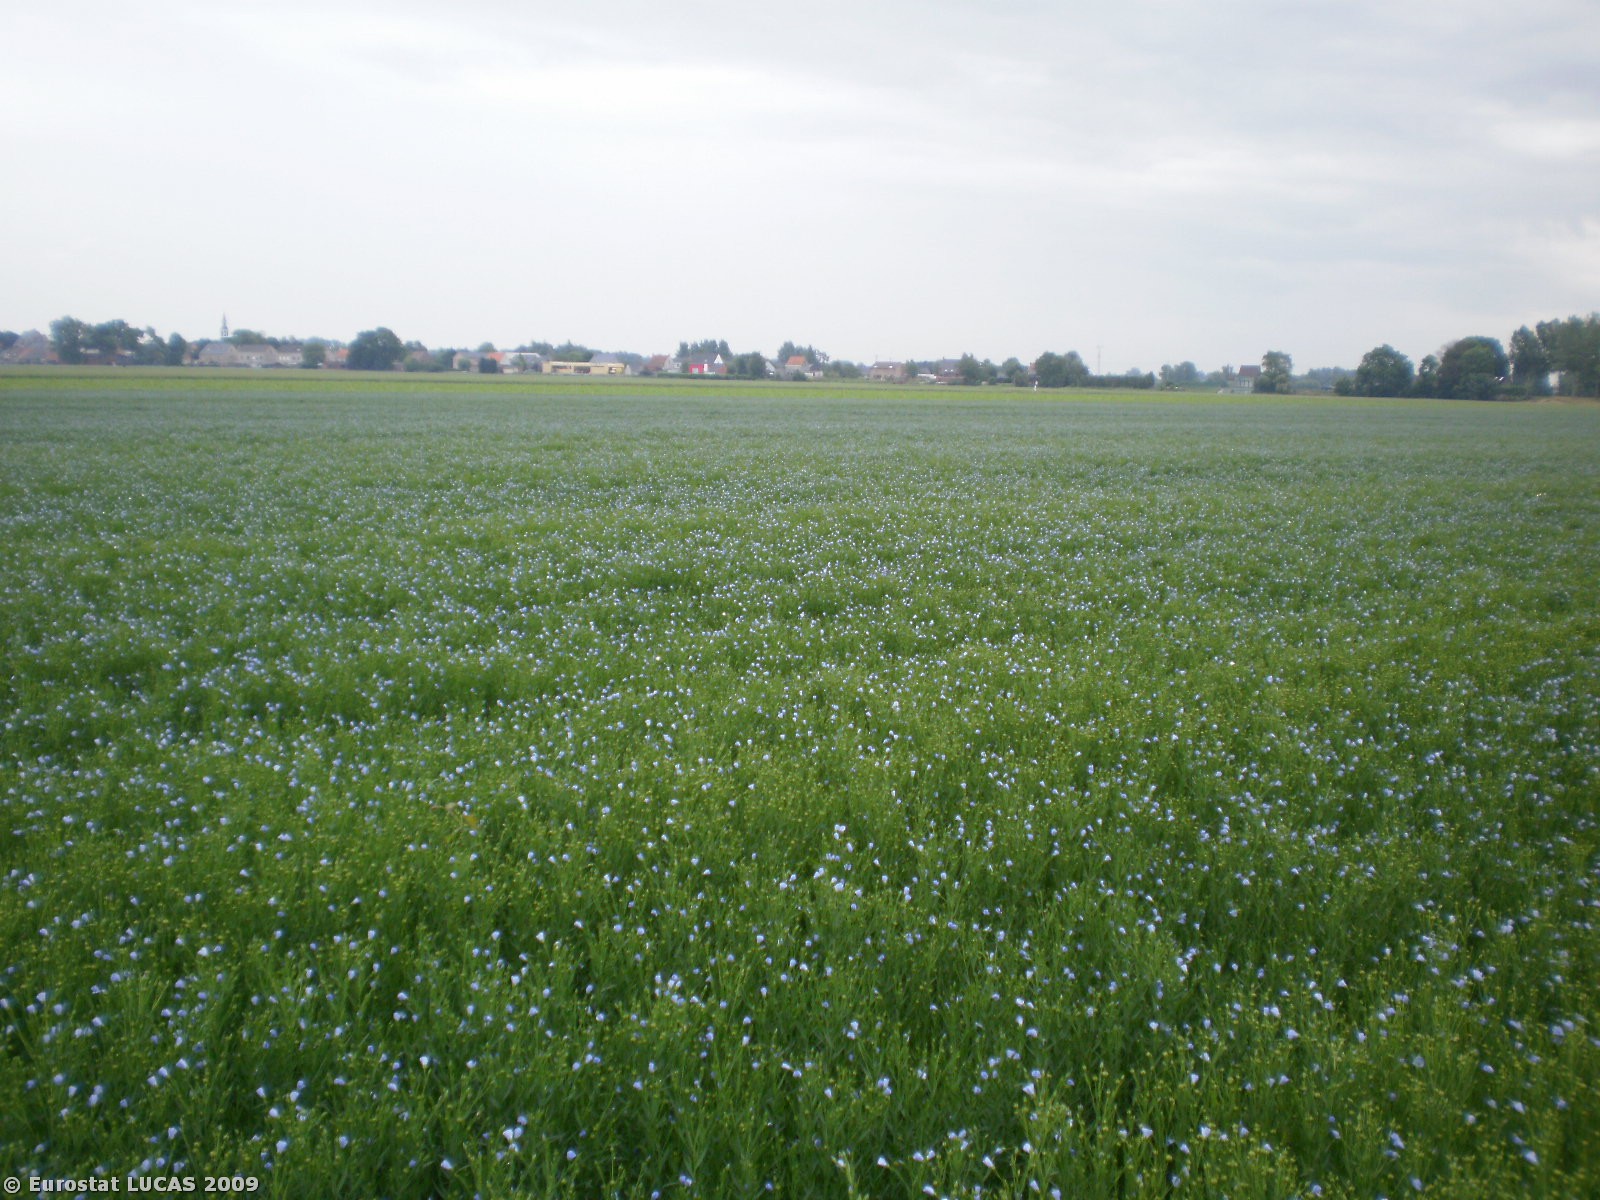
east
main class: Cropland
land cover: Other fibre and oleaginous crops
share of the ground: > 75 %
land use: Agriculture (excluding fallow land and kitchen gardens)
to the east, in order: Other fibre and oleaginous crops; Maize; Common wheat
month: June
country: BE
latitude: 51.2591
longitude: 4.1337
